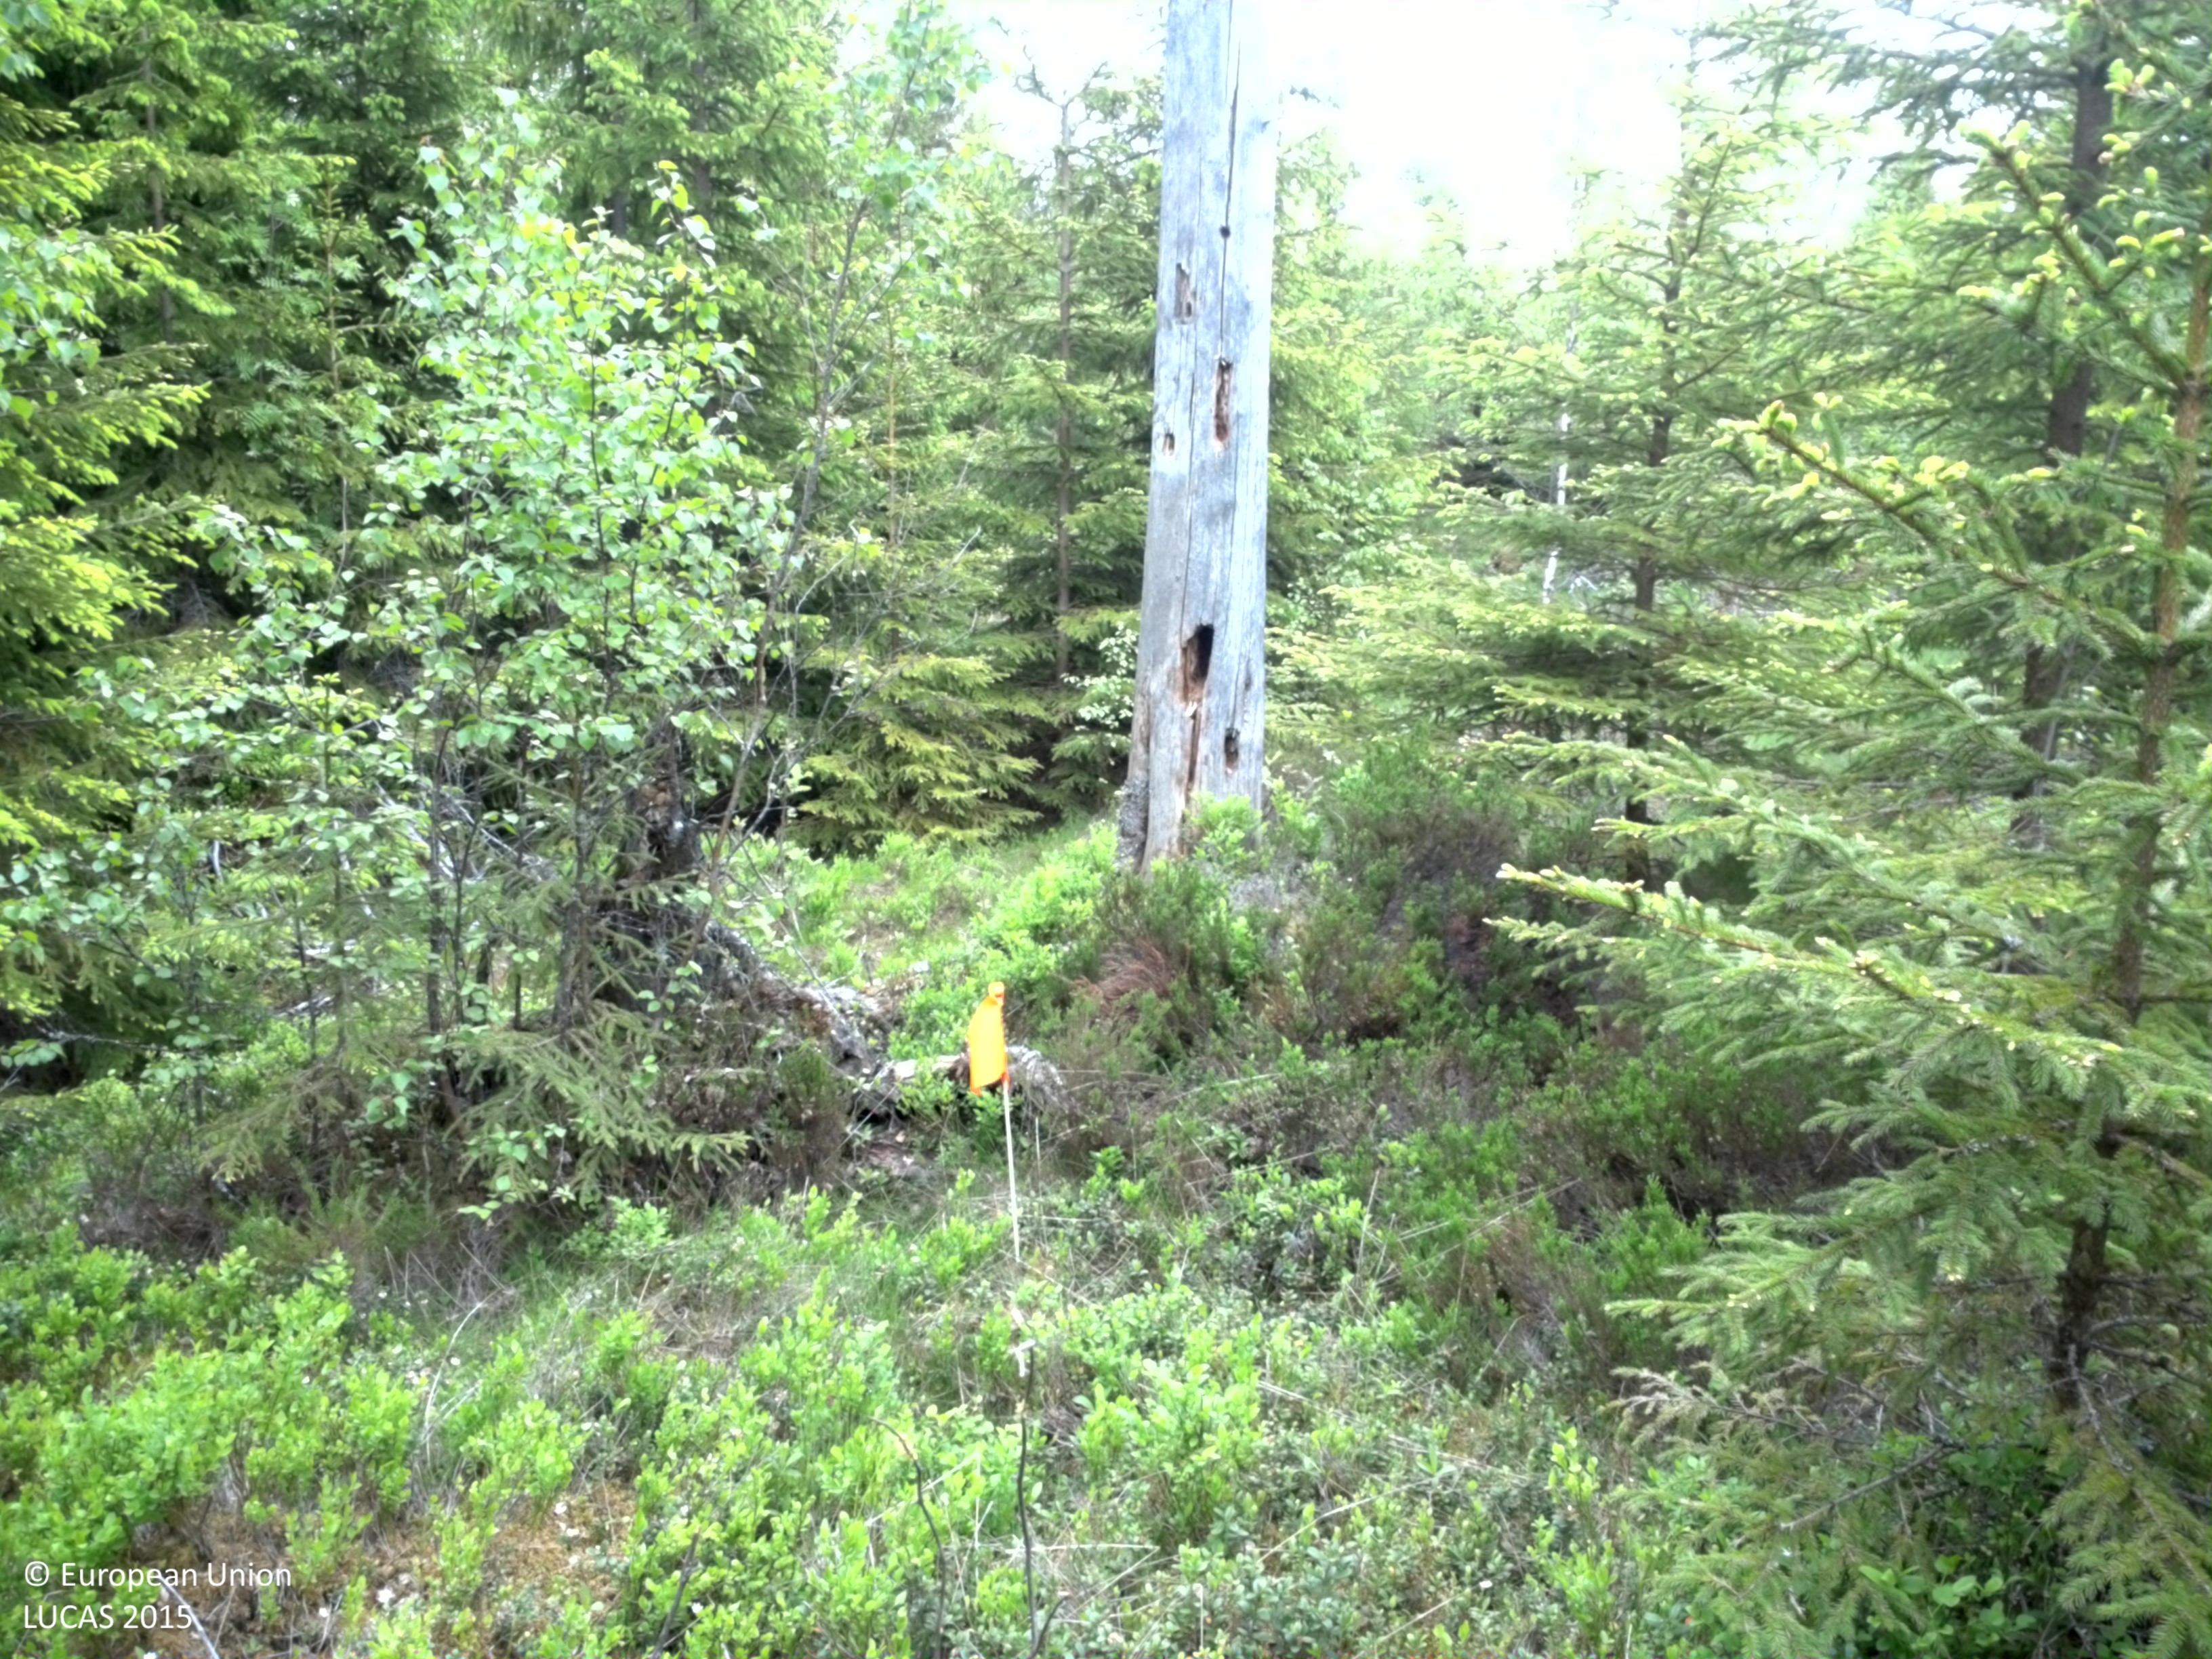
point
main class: Woodland
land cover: Spruce dominated mixed woodland
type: boreal forest
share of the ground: 50 - 75 %
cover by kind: coniferous forest trees 40 %, broadleaved forest trees 30 %, shrubs 15 %, herbaceous plants 10 %, lichens and mosses 5 %
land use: Forestry
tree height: < 5 m
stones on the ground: < 10 %
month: June
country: SE
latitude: 59.5892
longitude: 14.4008
